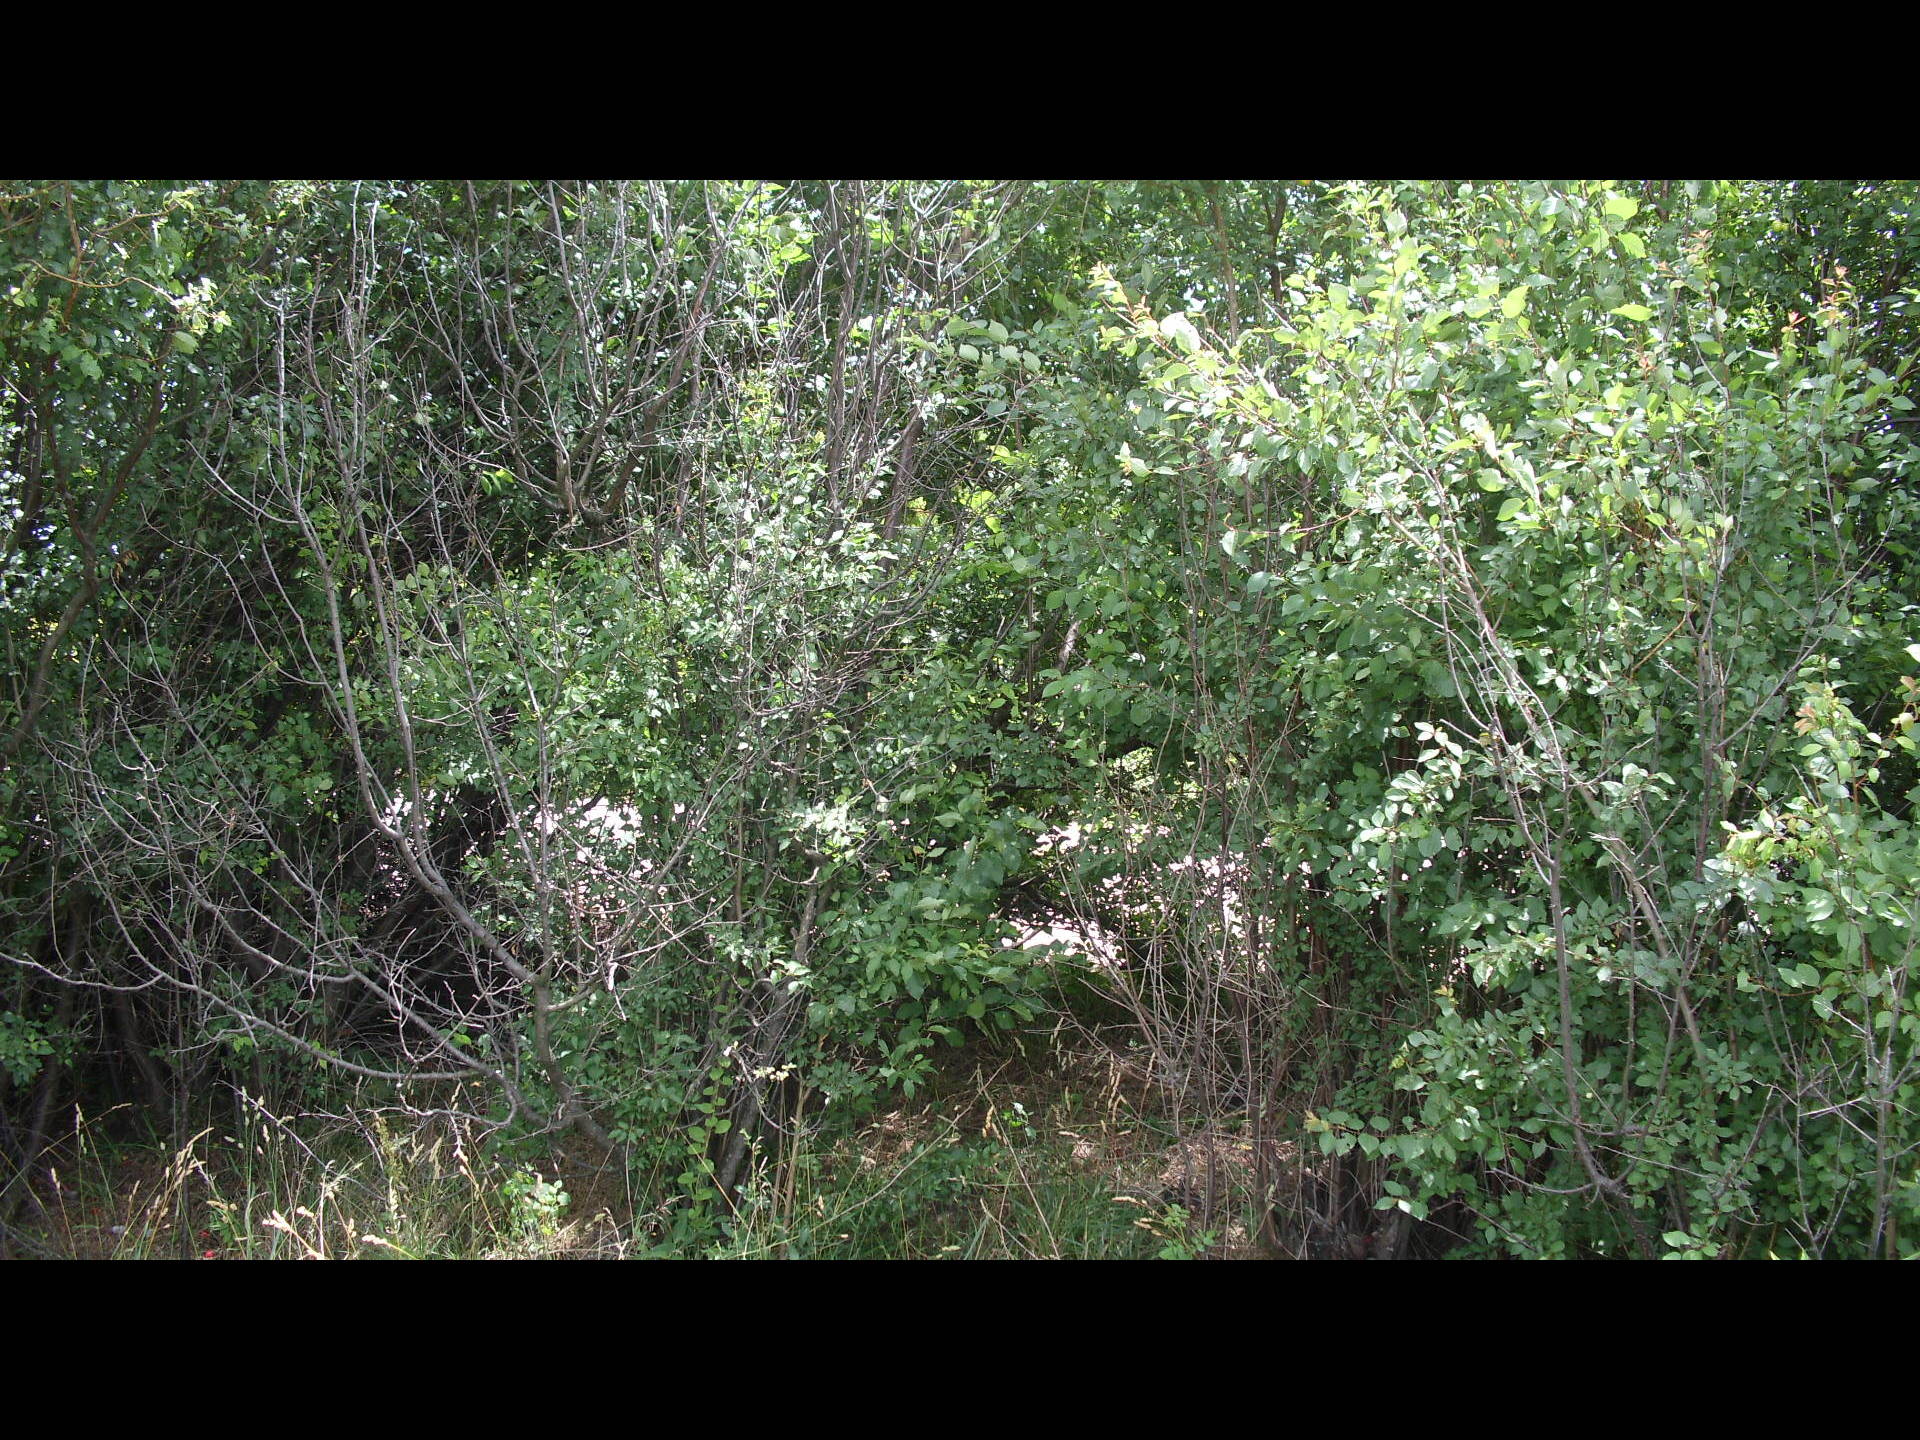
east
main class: Cropland
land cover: Sunflower
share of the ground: > 75 %
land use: Agriculture (excluding fallow land and kitchen gardens)
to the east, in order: Sunflower; Grass margins; Lines of trees; Paved roads, cycling and walking lanes; Grassland with sparse tree/shrub cover; Ditches and canals; Grassland with sparse tree/shrub cover; Sunflower
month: June
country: BG
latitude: 43.6226
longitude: 23.5419
